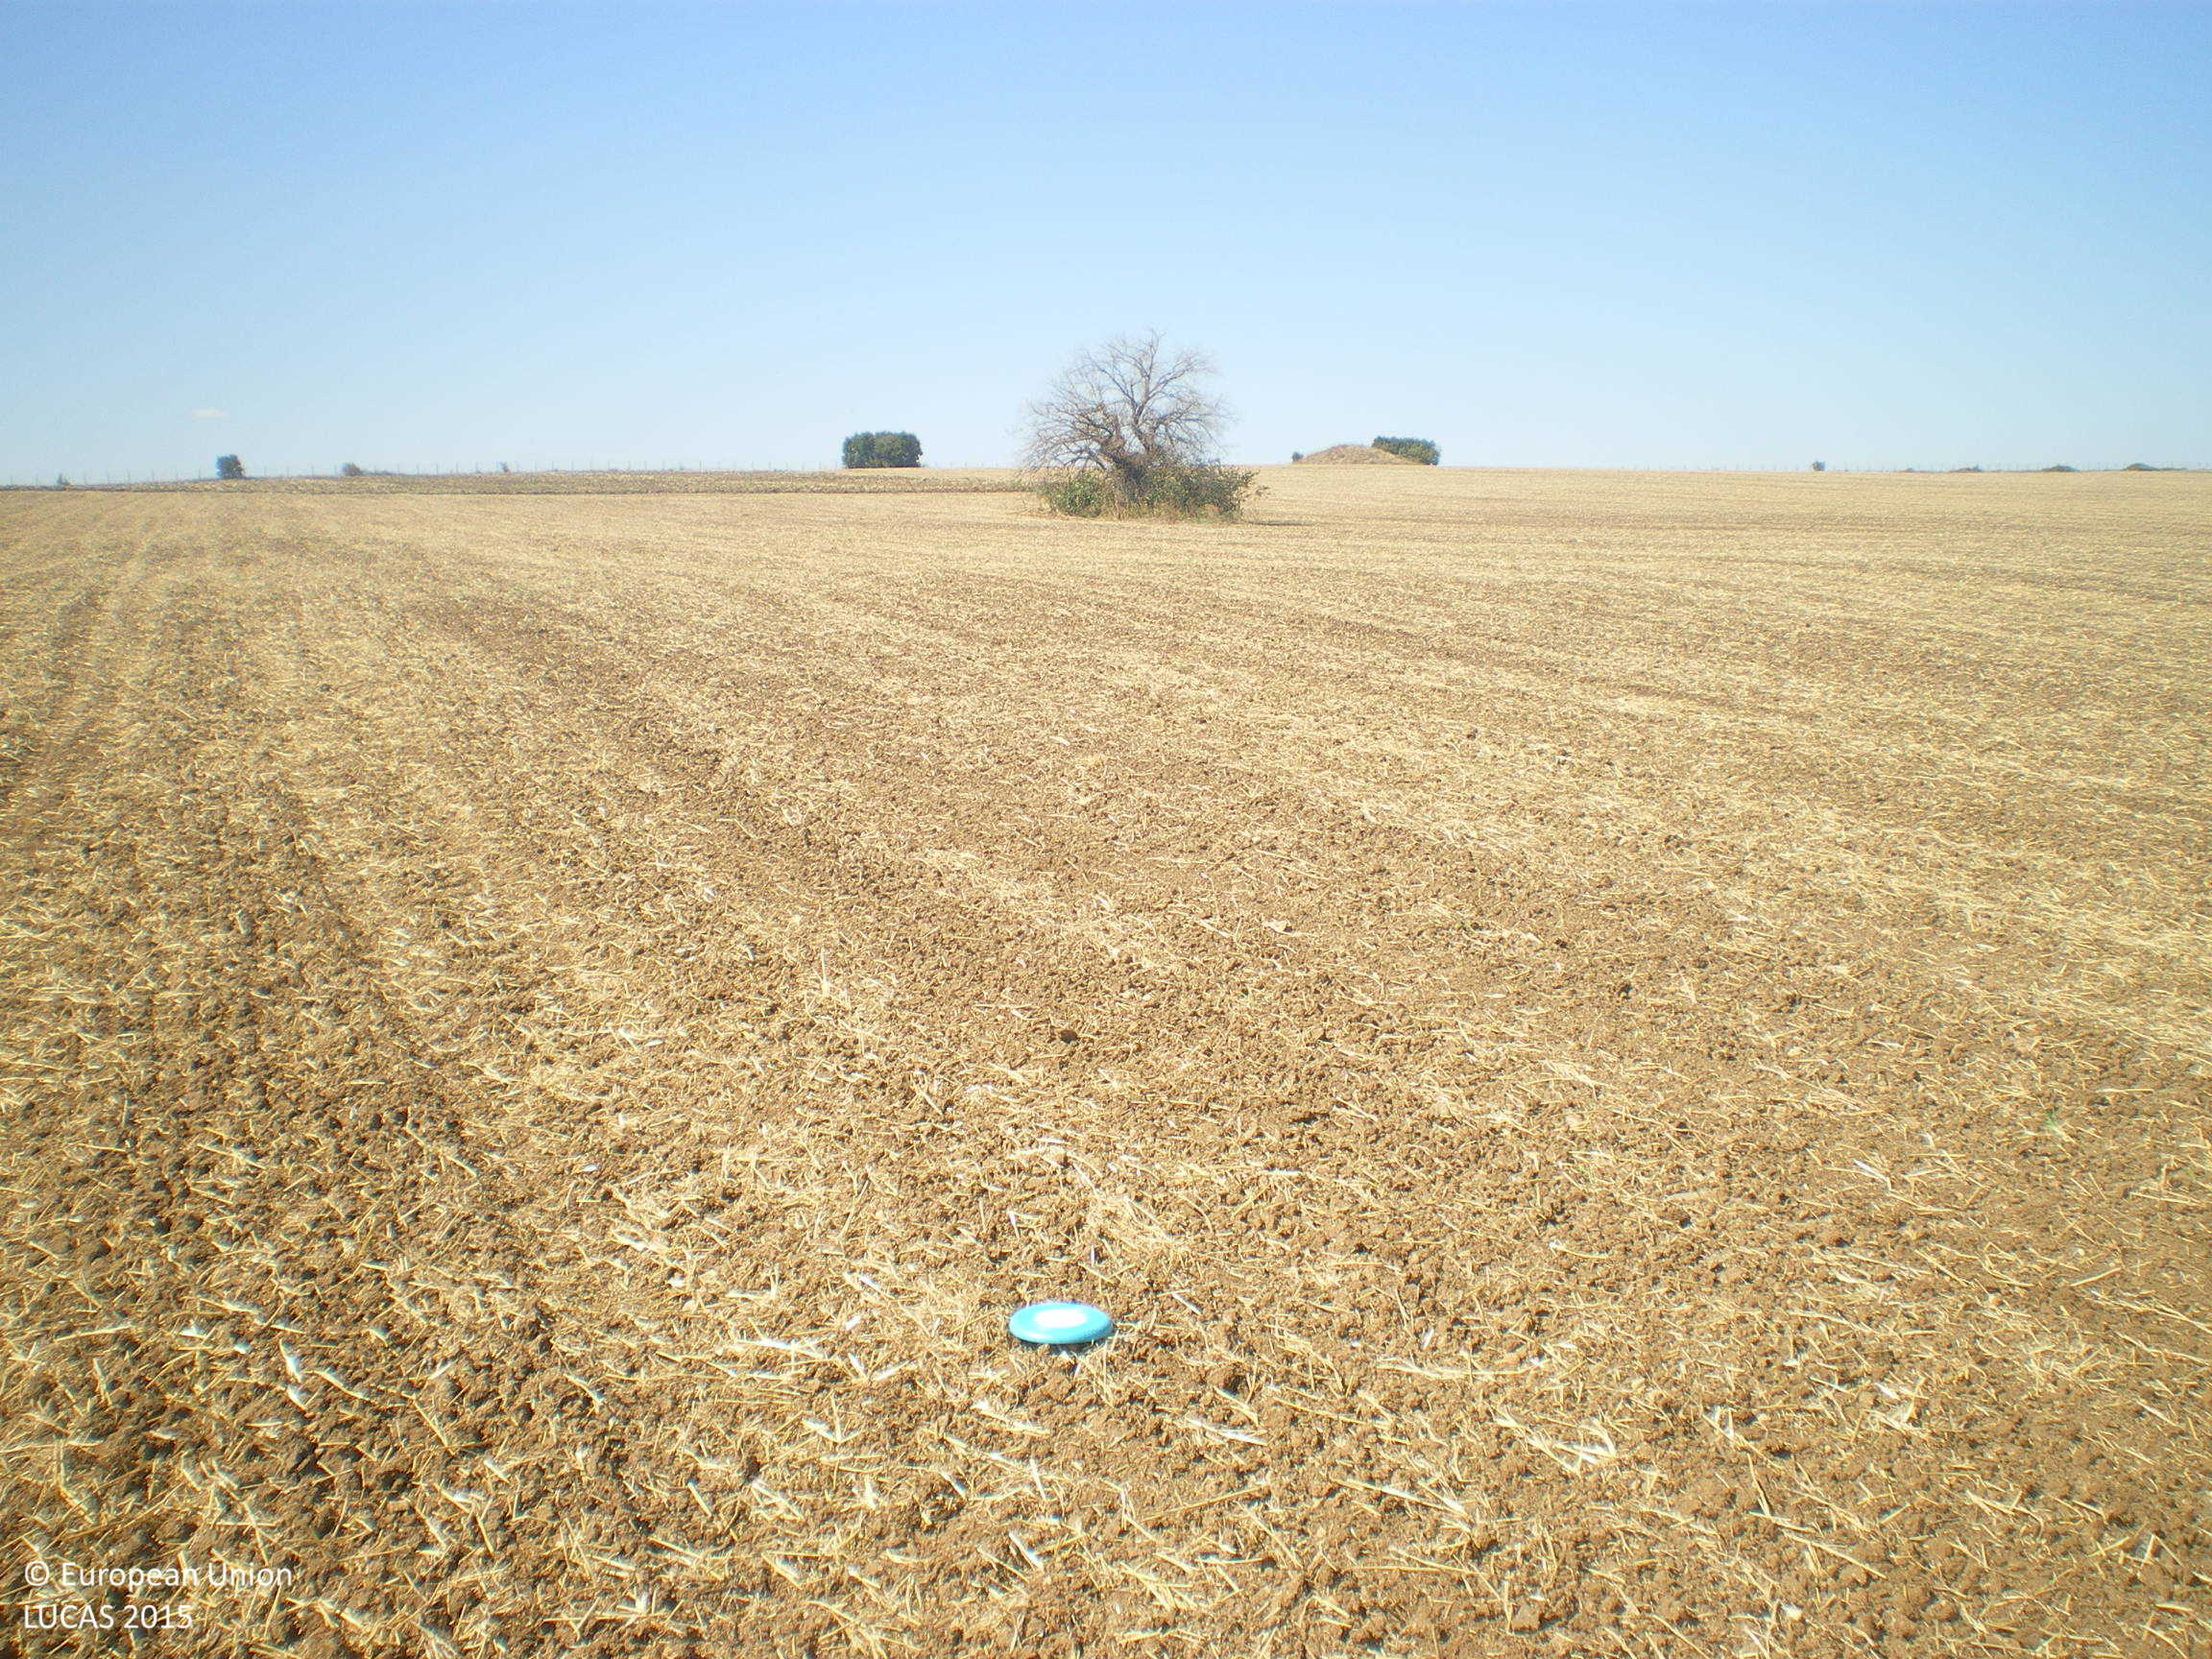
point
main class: Cropland
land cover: Common wheat
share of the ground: < 10 %
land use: Agriculture (excluding fallow land and kitchen gardens)
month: September
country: BG
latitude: 41.7775
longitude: 26.3327
